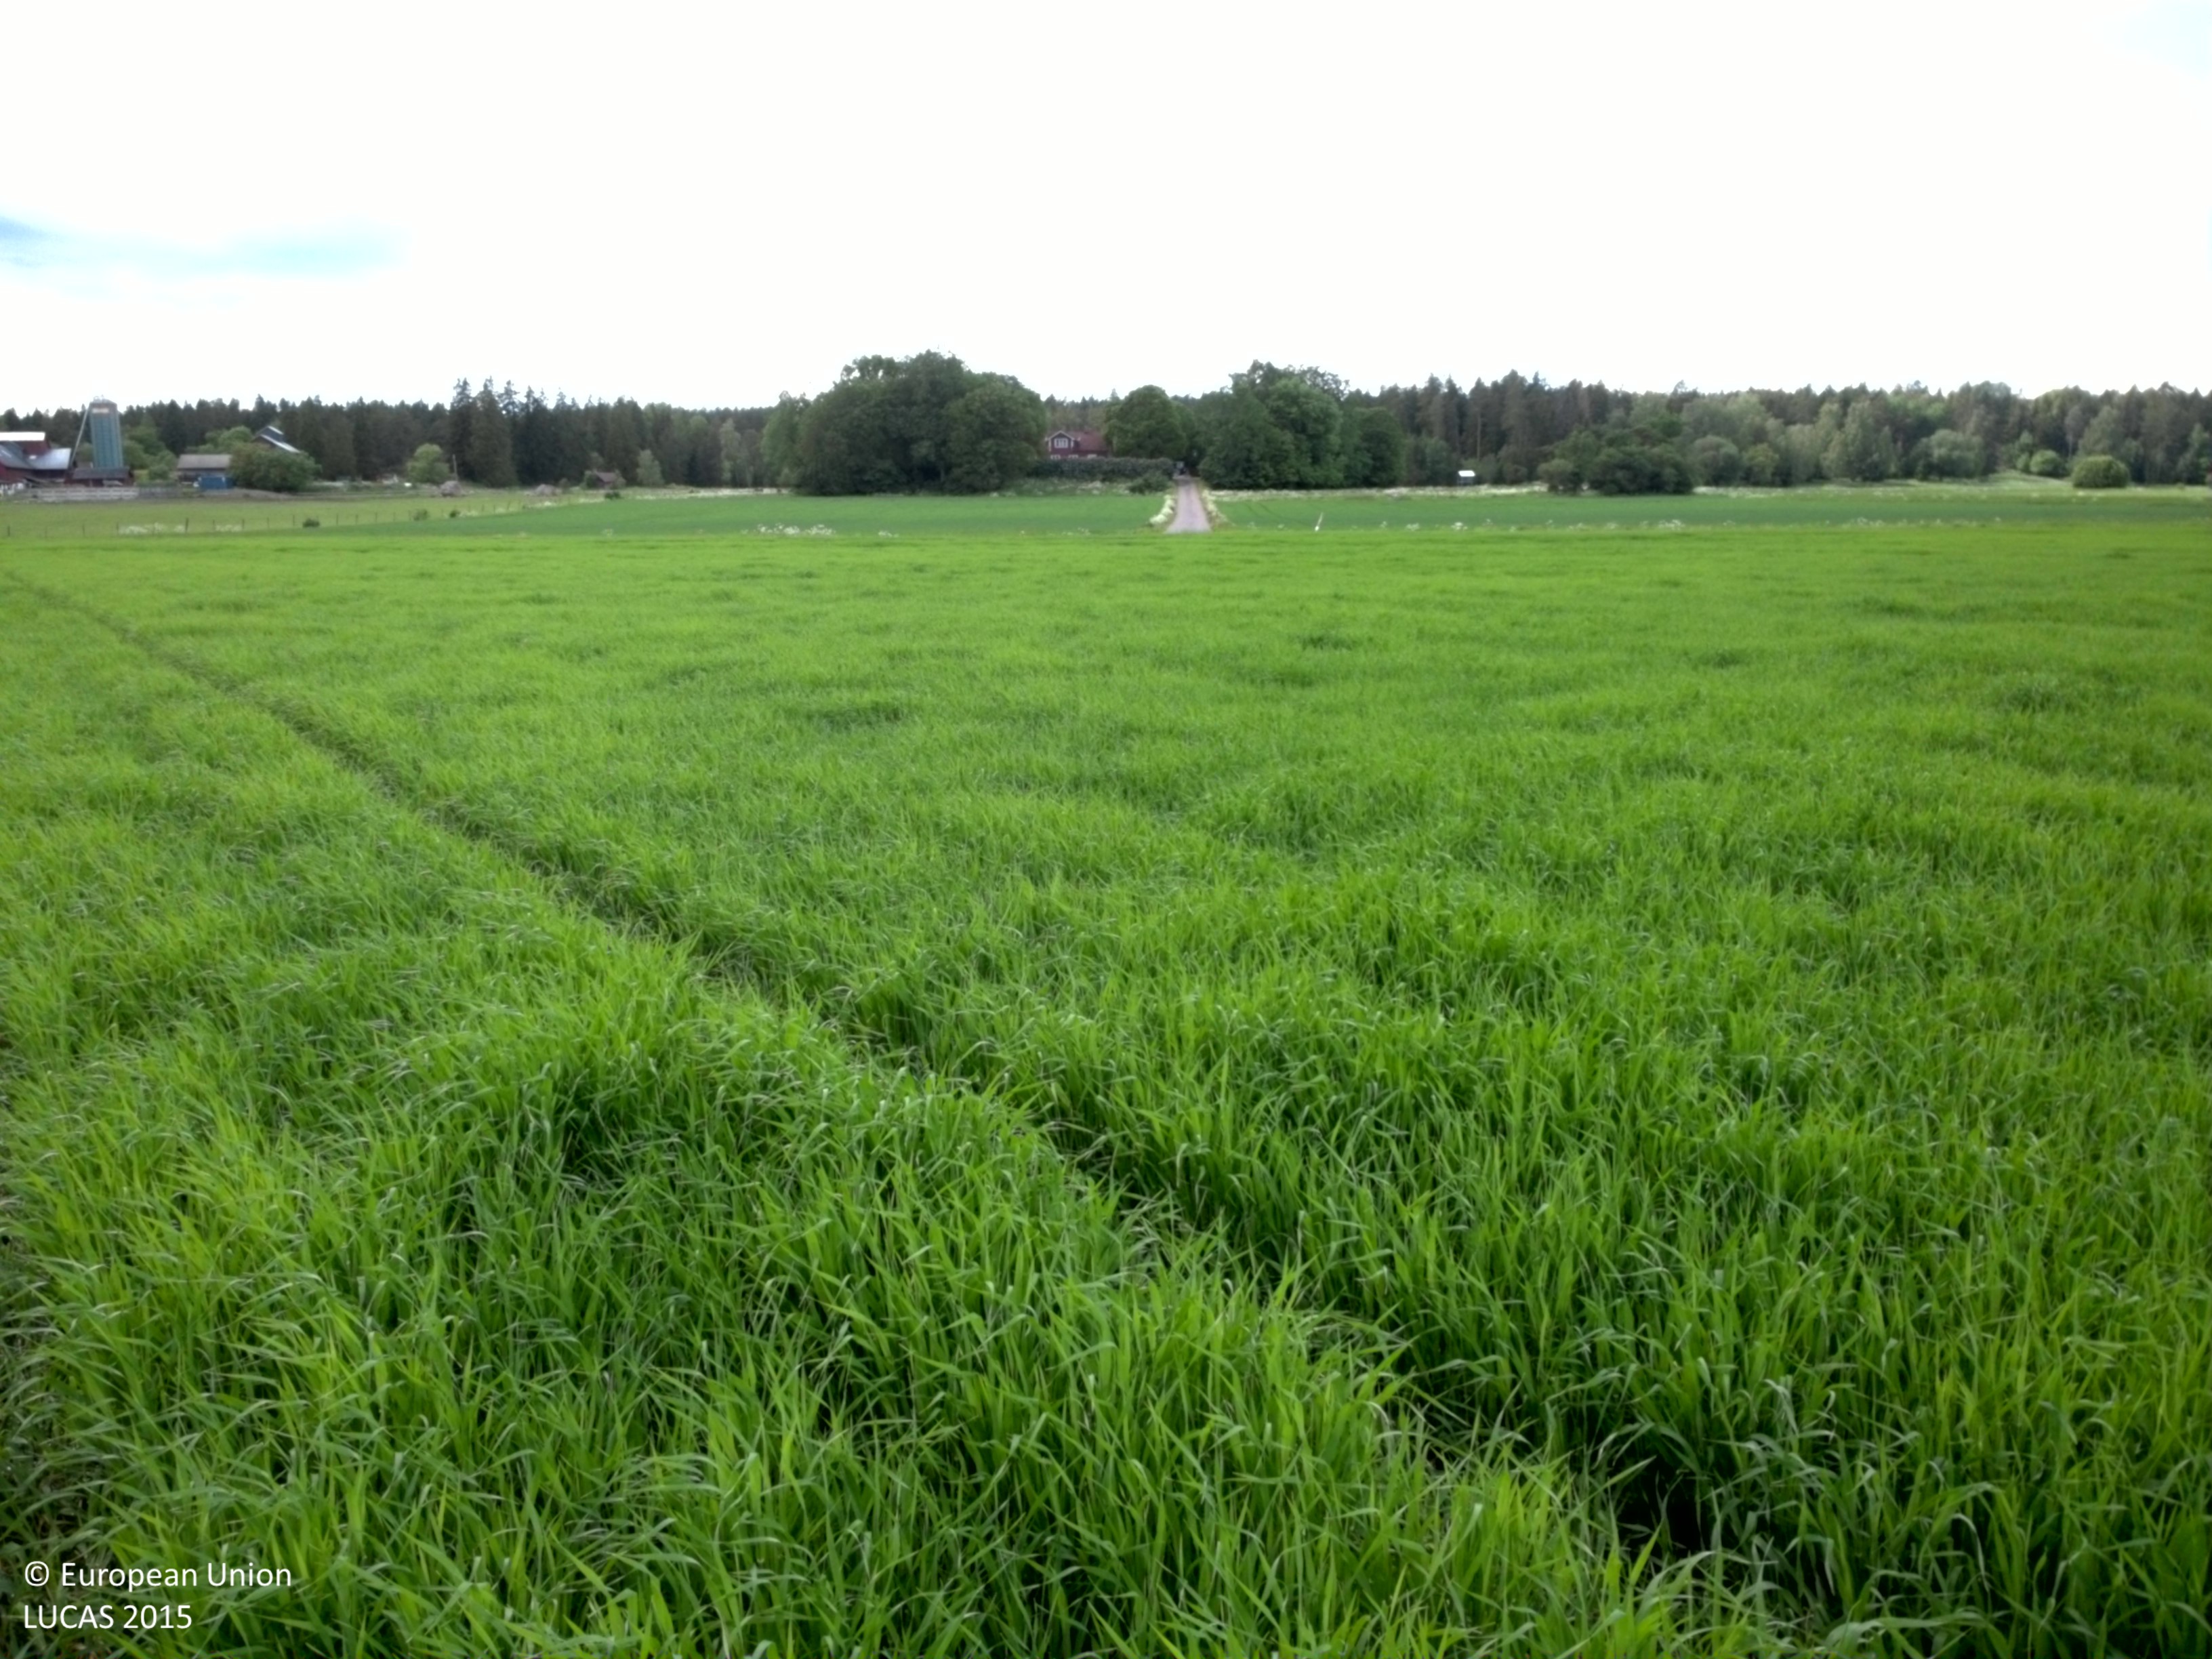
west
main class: Cropland
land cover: Barley
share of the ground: 25 - 50 %
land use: Agriculture (excluding fallow land and kitchen gardens)
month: June
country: SE
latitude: 59.9094
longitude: 17.4858
